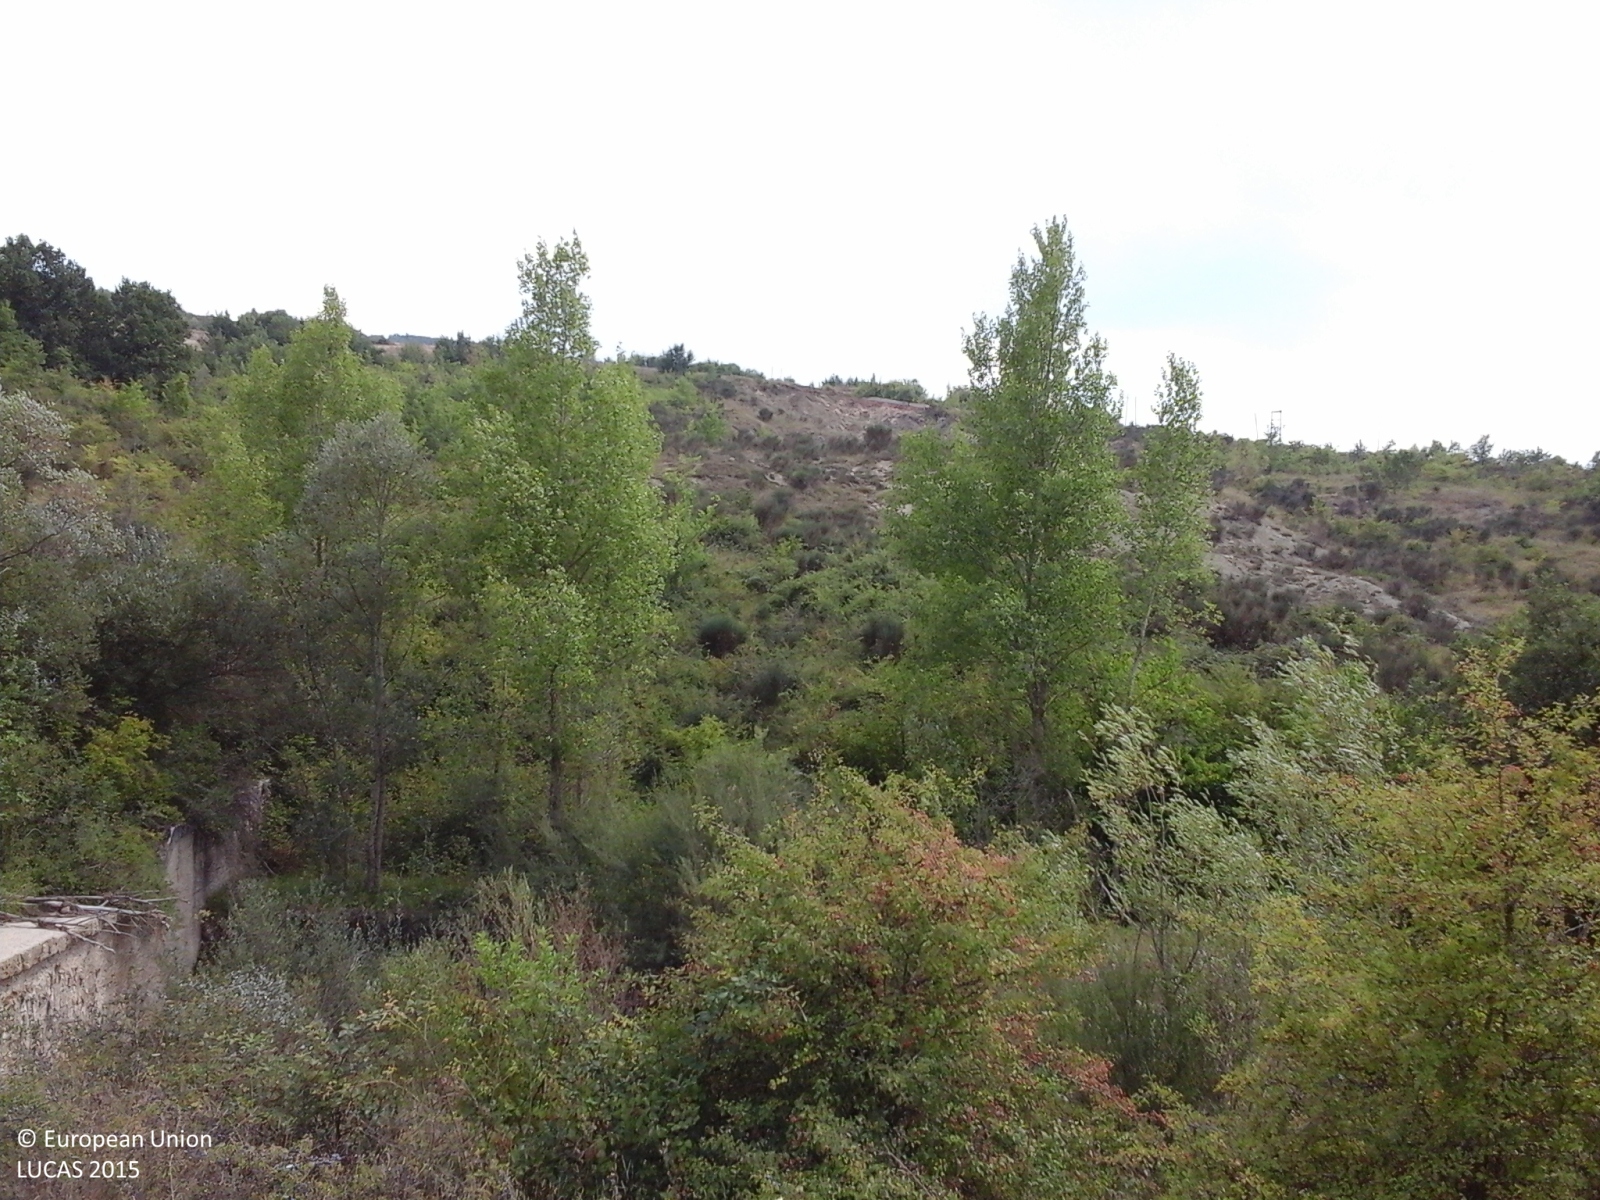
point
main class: Shrubland
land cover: Shrubland with sparse tree cover
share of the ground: > 75 %
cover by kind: shrubs 45 %, consolidated bare surface 45 %, broadleaved forest trees 5 %, herbaceous plants 5 %
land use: Semi-natural and natural areas not in use
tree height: < 5 m
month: August
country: IT
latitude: 41.7041
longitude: 14.4911
